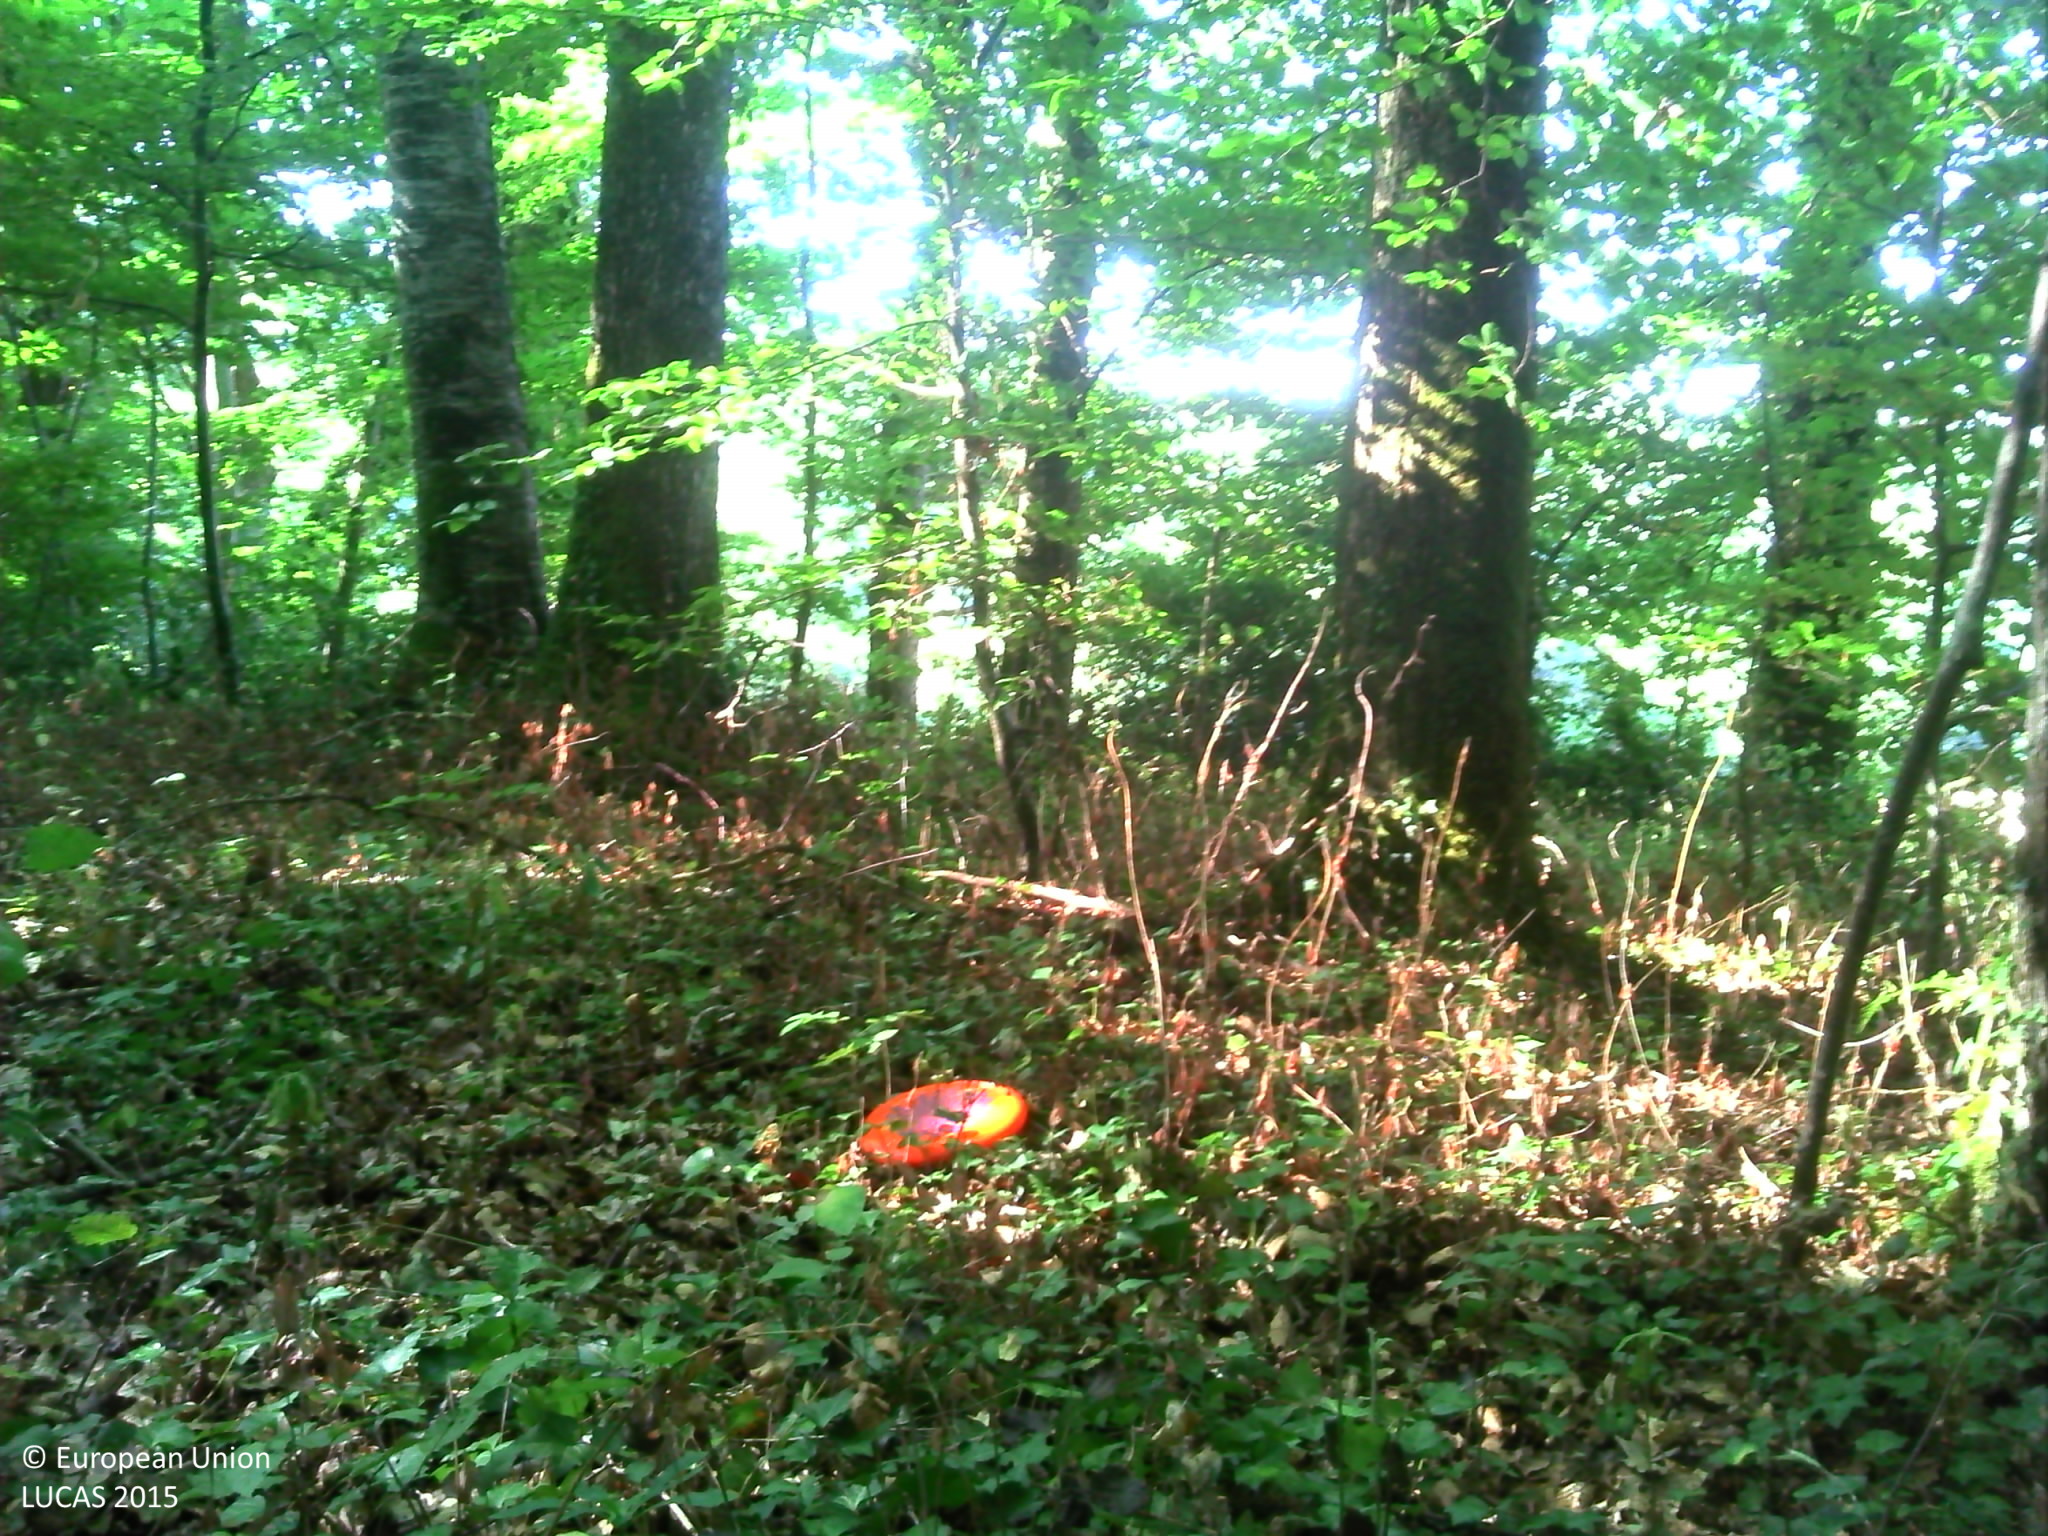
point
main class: Woodland
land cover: Broadleaved woodland
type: acidophilous oak and oak-birch forest
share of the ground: > 75 %
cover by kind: broadleaved forest trees 40 %, herbaceous plants 20 %, lichens and mosses 20 %, unconsolidated bare surface 20 %
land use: Forestry
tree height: > 5 m
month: July
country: FR
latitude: 45.6828
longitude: 1.4545
